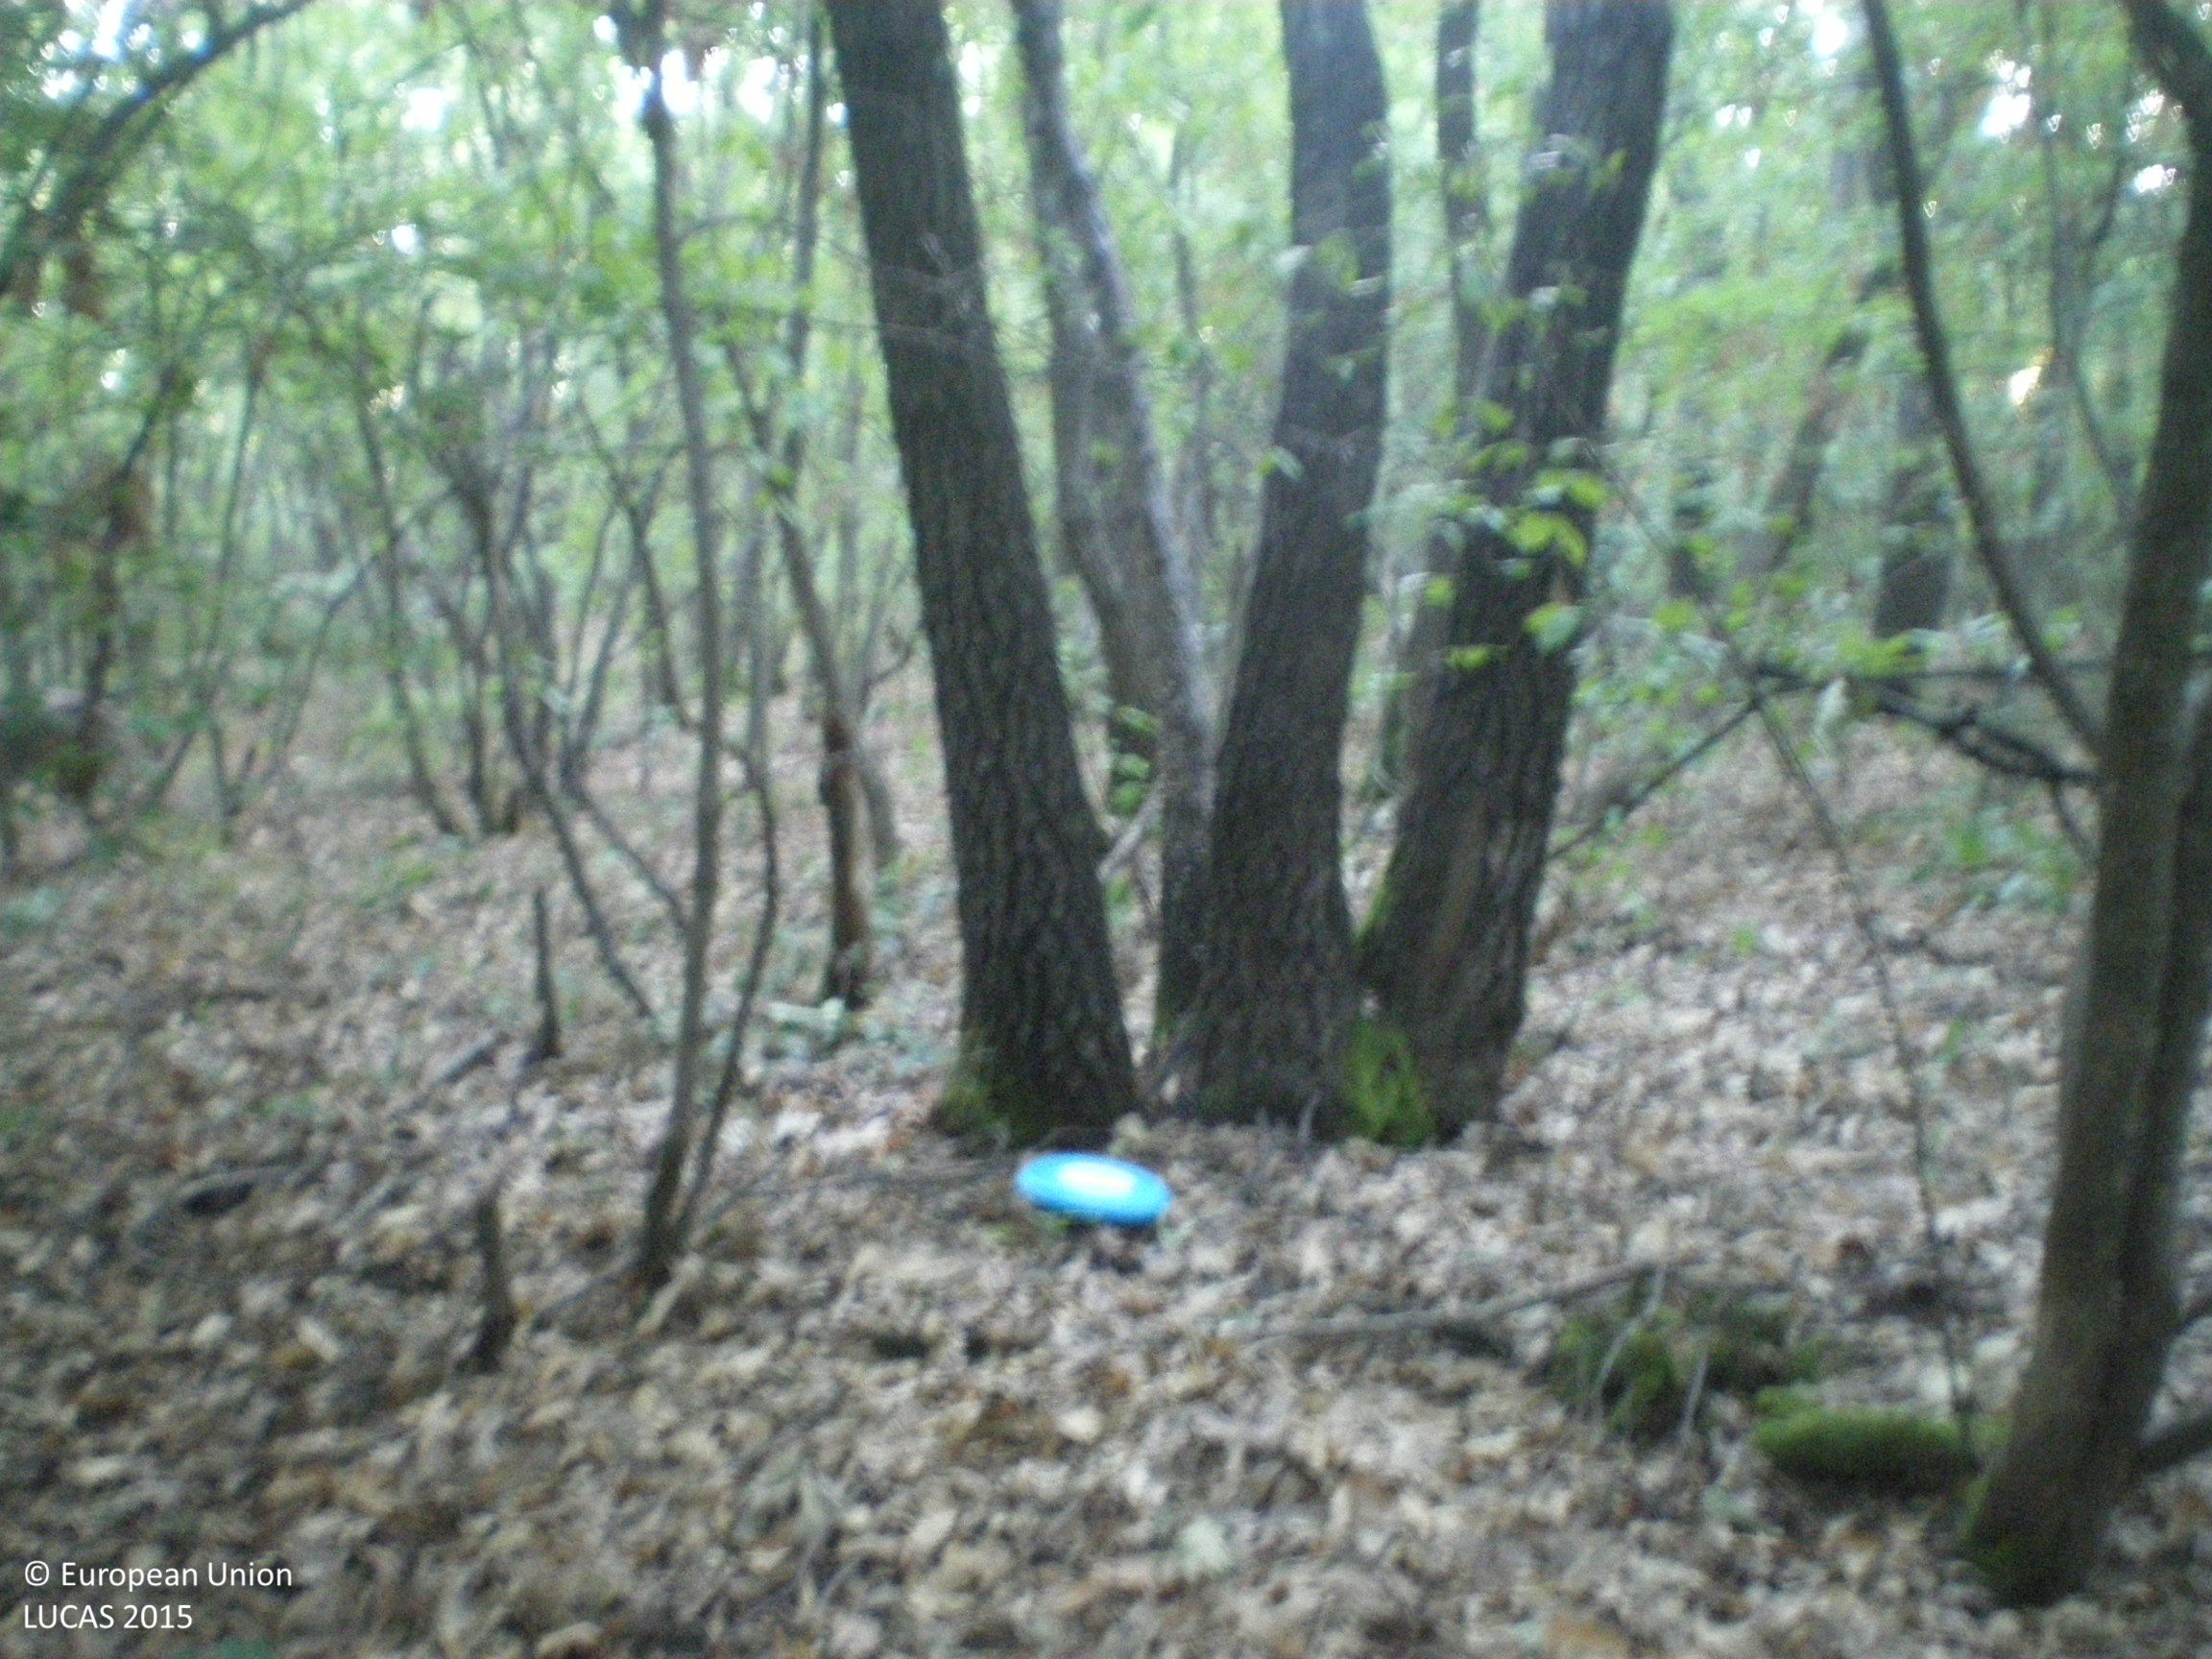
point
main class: Woodland
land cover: Broadleaved woodland
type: mesophytic deciduous forest
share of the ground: > 75 %
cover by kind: broadleaved forest trees 95 %, unconsolidated bare surface 5 %
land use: Forestry
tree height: > 5 m
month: August
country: BG
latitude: 42.4616
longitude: 25.5021
